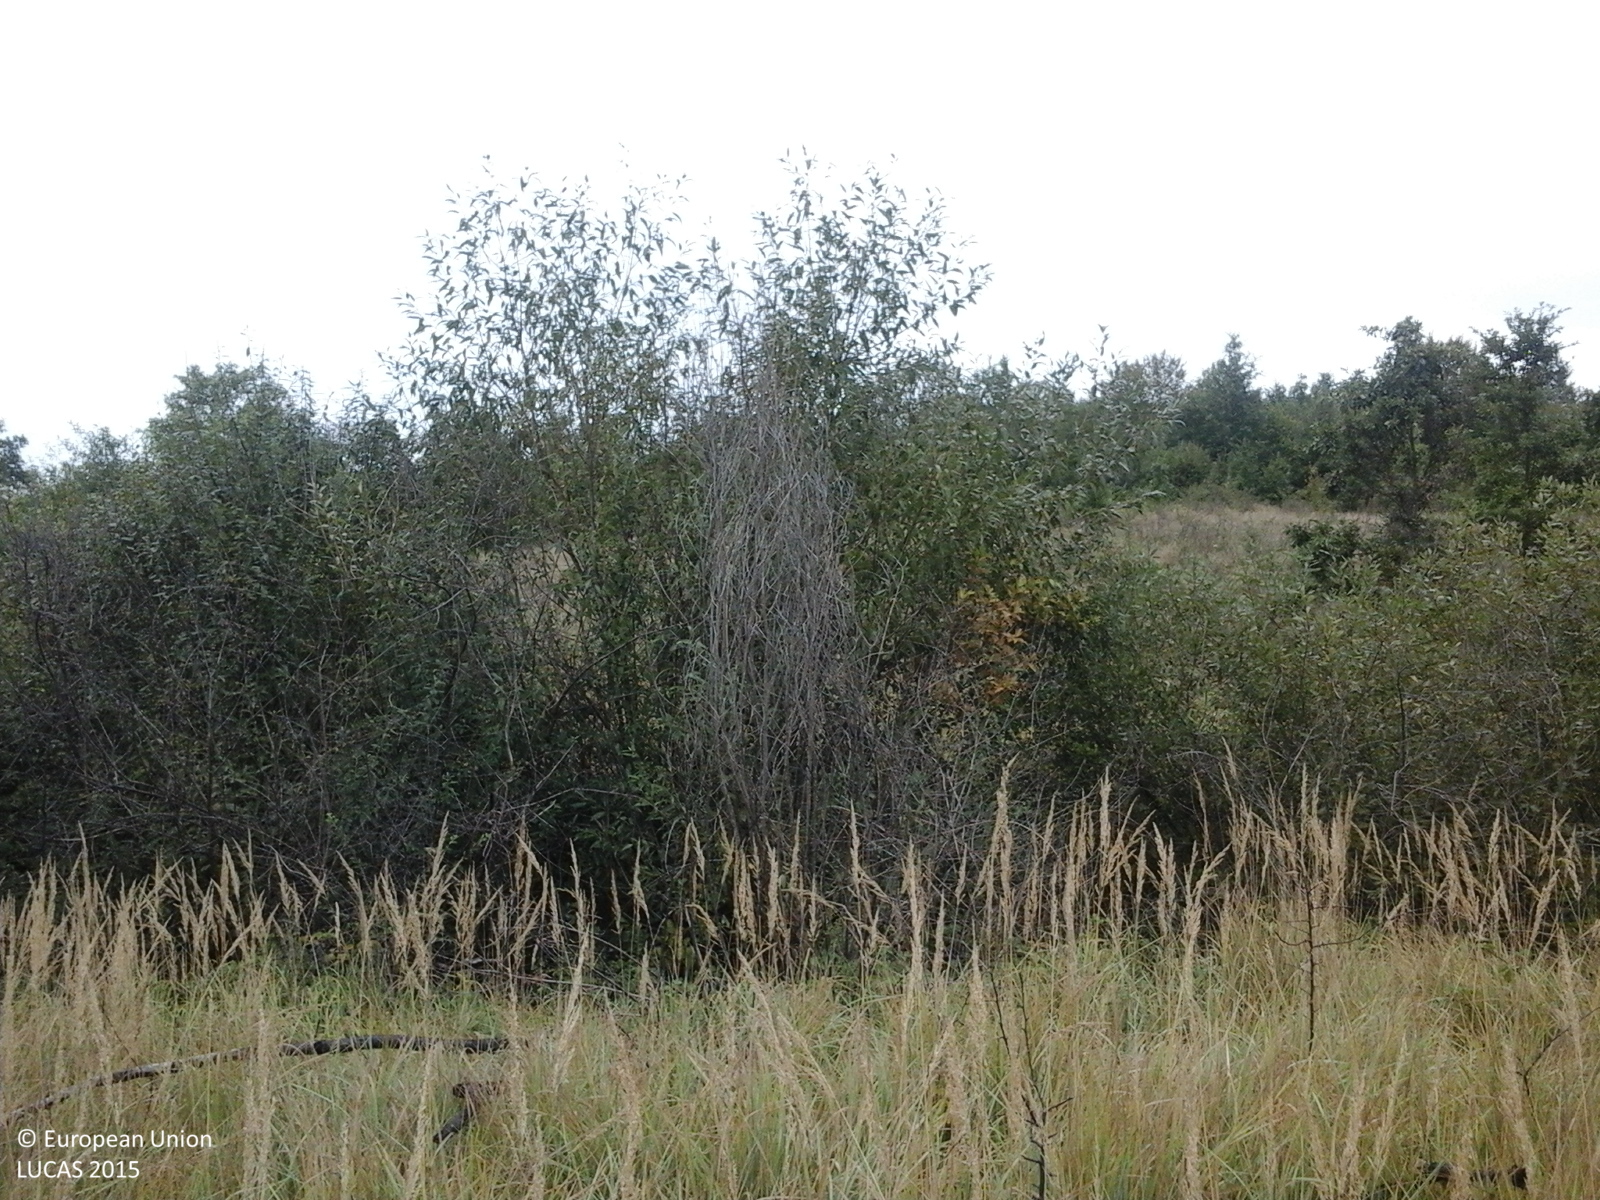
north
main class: Grassland
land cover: Spontaneously vegetated surfaces
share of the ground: > 75 %
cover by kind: herbaceous plants 100 %
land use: Fallow land
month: September
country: RO
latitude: 45.9552
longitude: 22.2369
